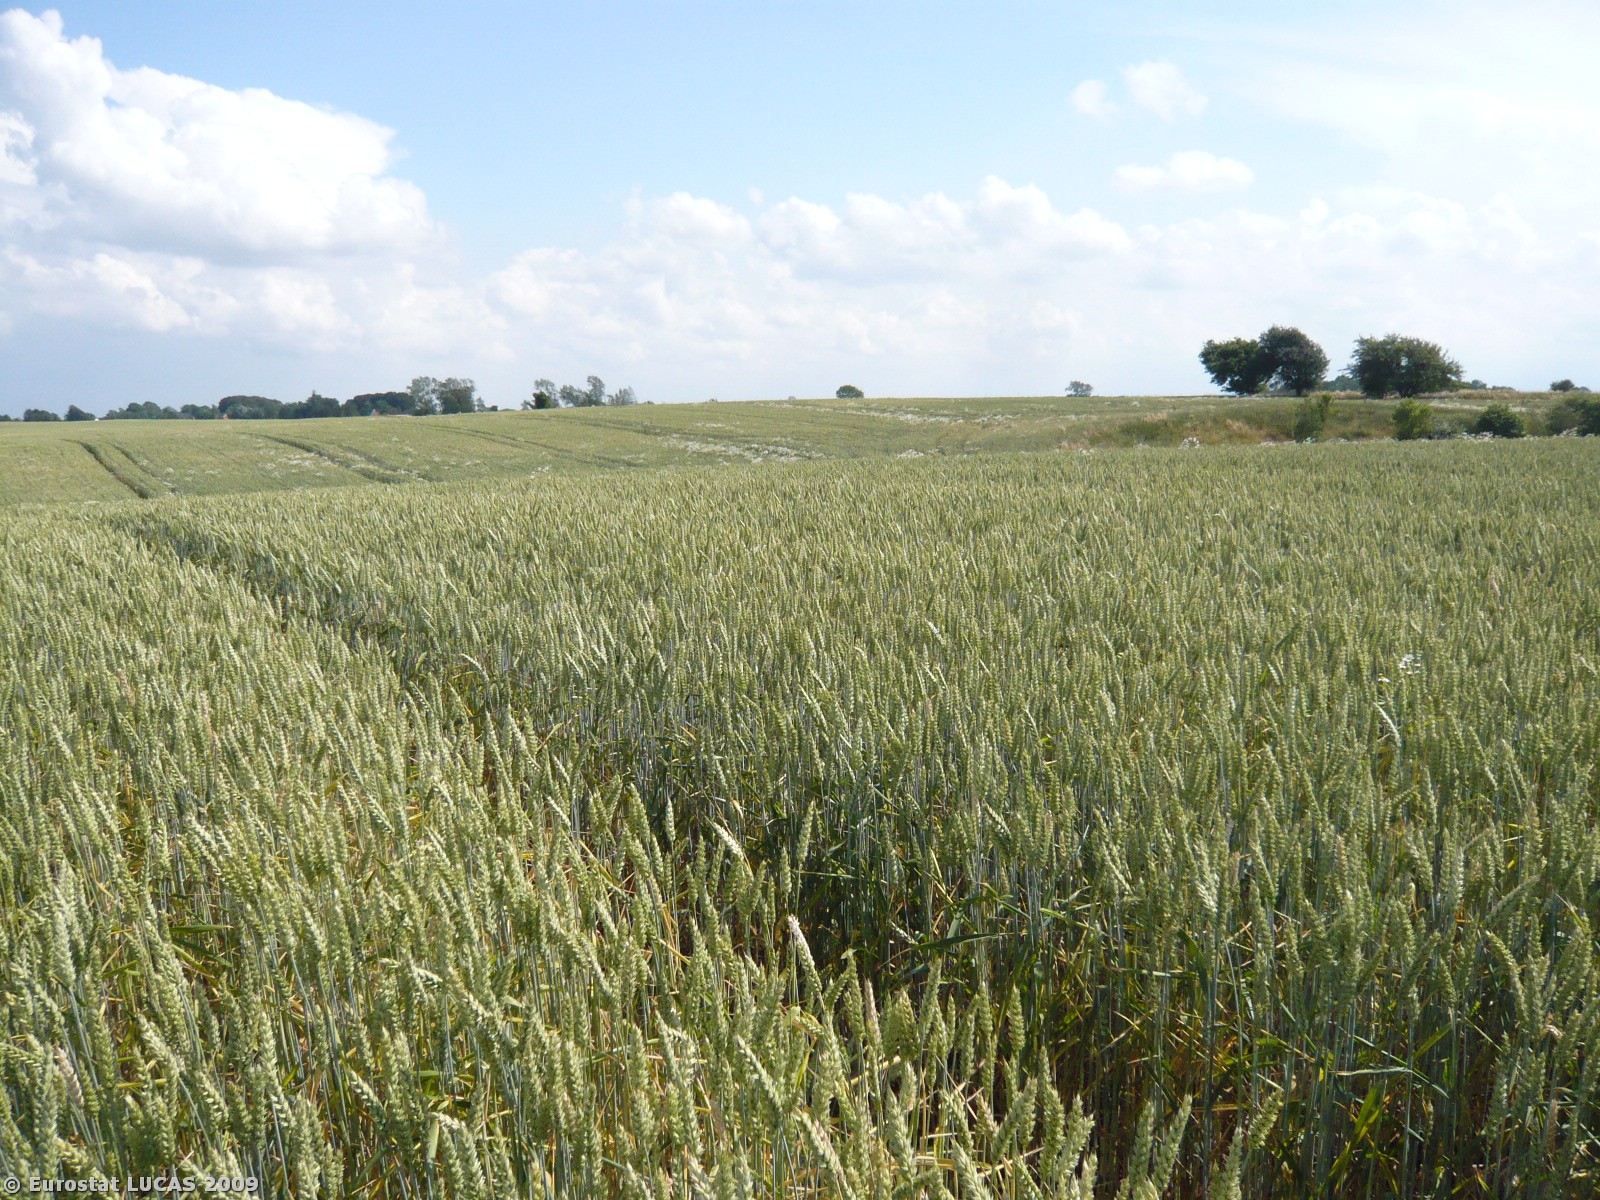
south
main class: Cropland
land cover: Common wheat
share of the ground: > 75 %
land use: Agriculture (excluding fallow land and kitchen gardens)
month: July
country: DK
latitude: 55.5046
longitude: 10.1740
